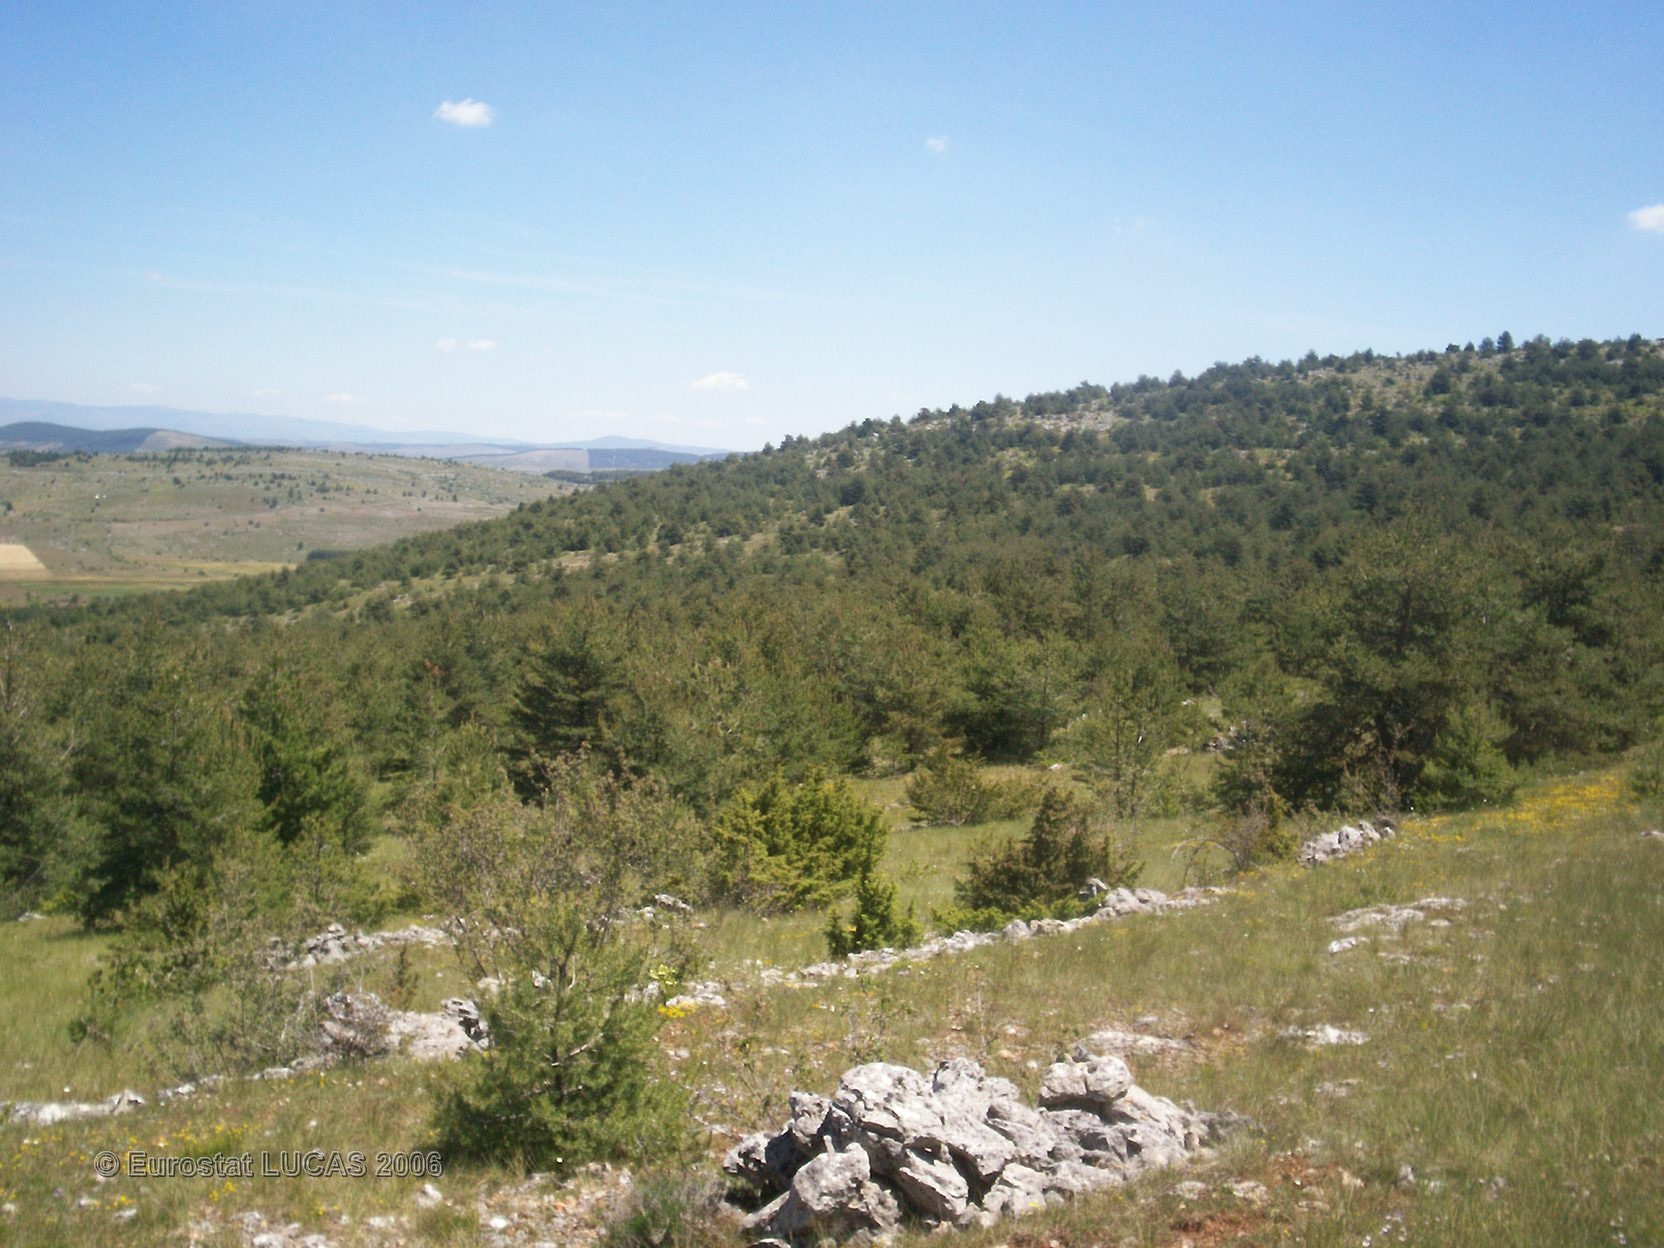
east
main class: Grassland
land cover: Grassland with sparse tree/shrub cover
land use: Agriculture (excluding fallow land and kitchen gardens)
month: June
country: FR
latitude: 44.2673
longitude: 3.4041
